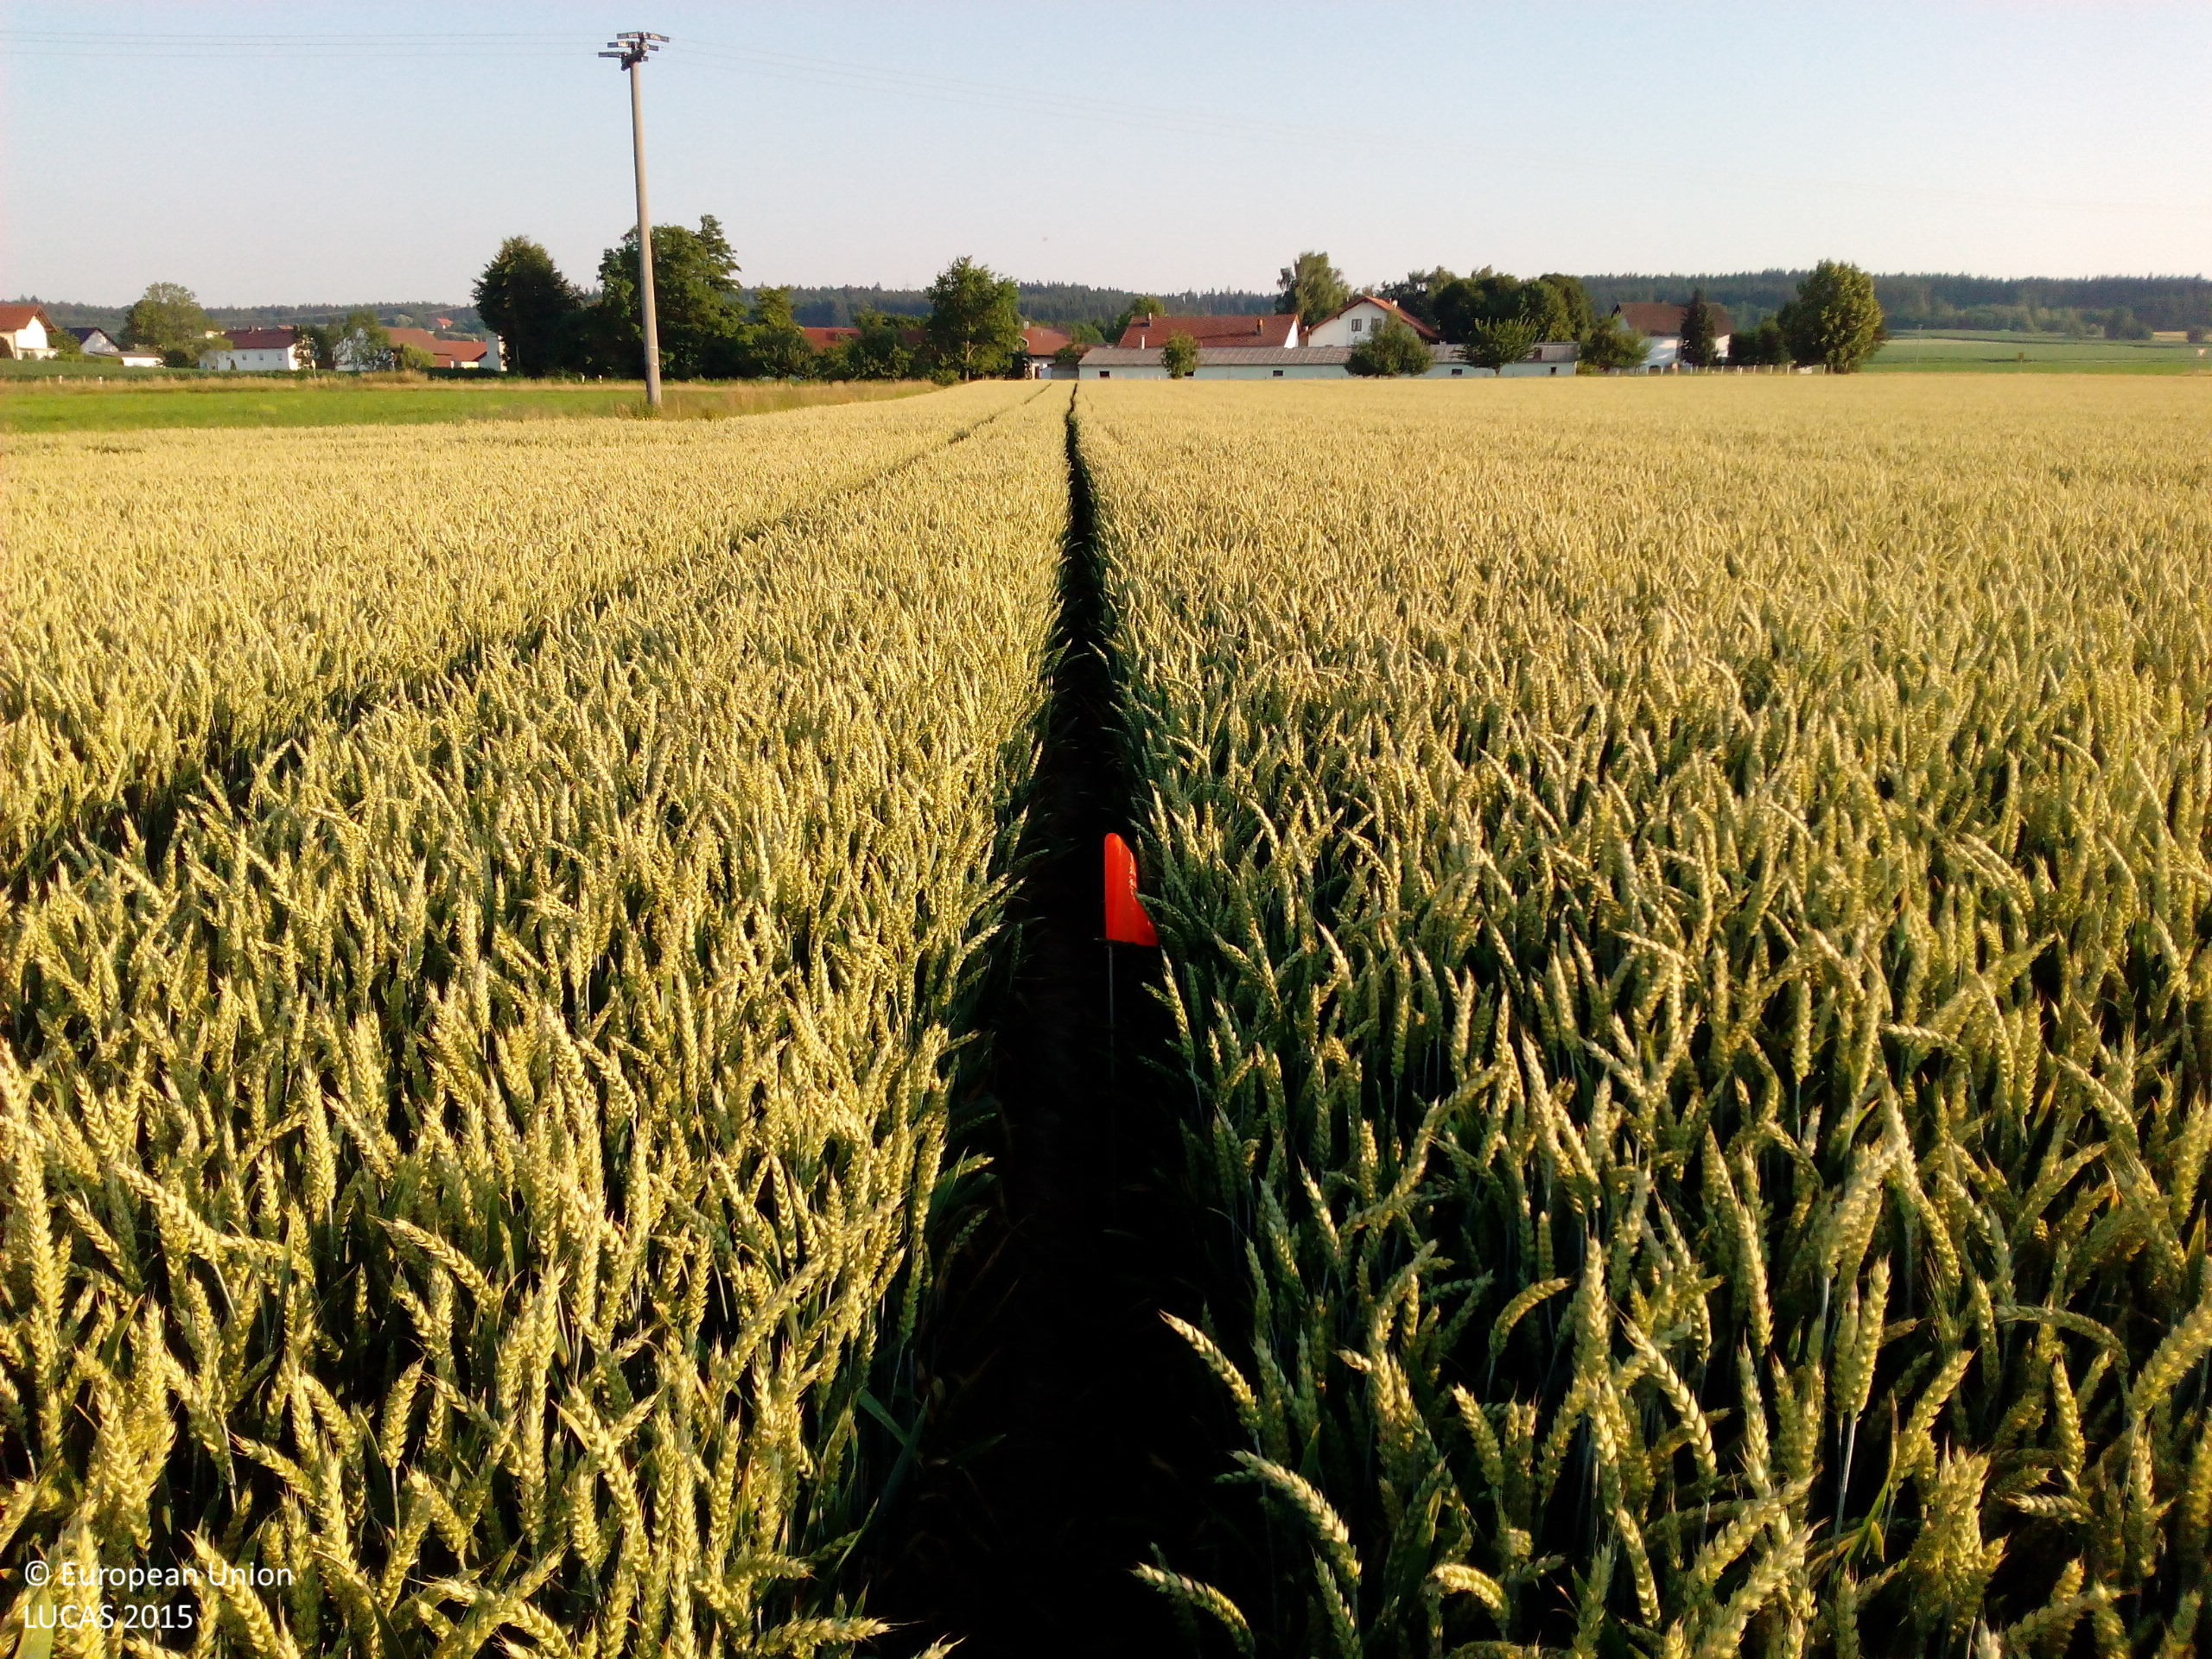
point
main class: Cropland
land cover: Common wheat
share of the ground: > 75 %
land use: Agriculture (excluding fallow land and kitchen gardens)
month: July
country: DE
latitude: 48.6703
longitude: 12.9461
